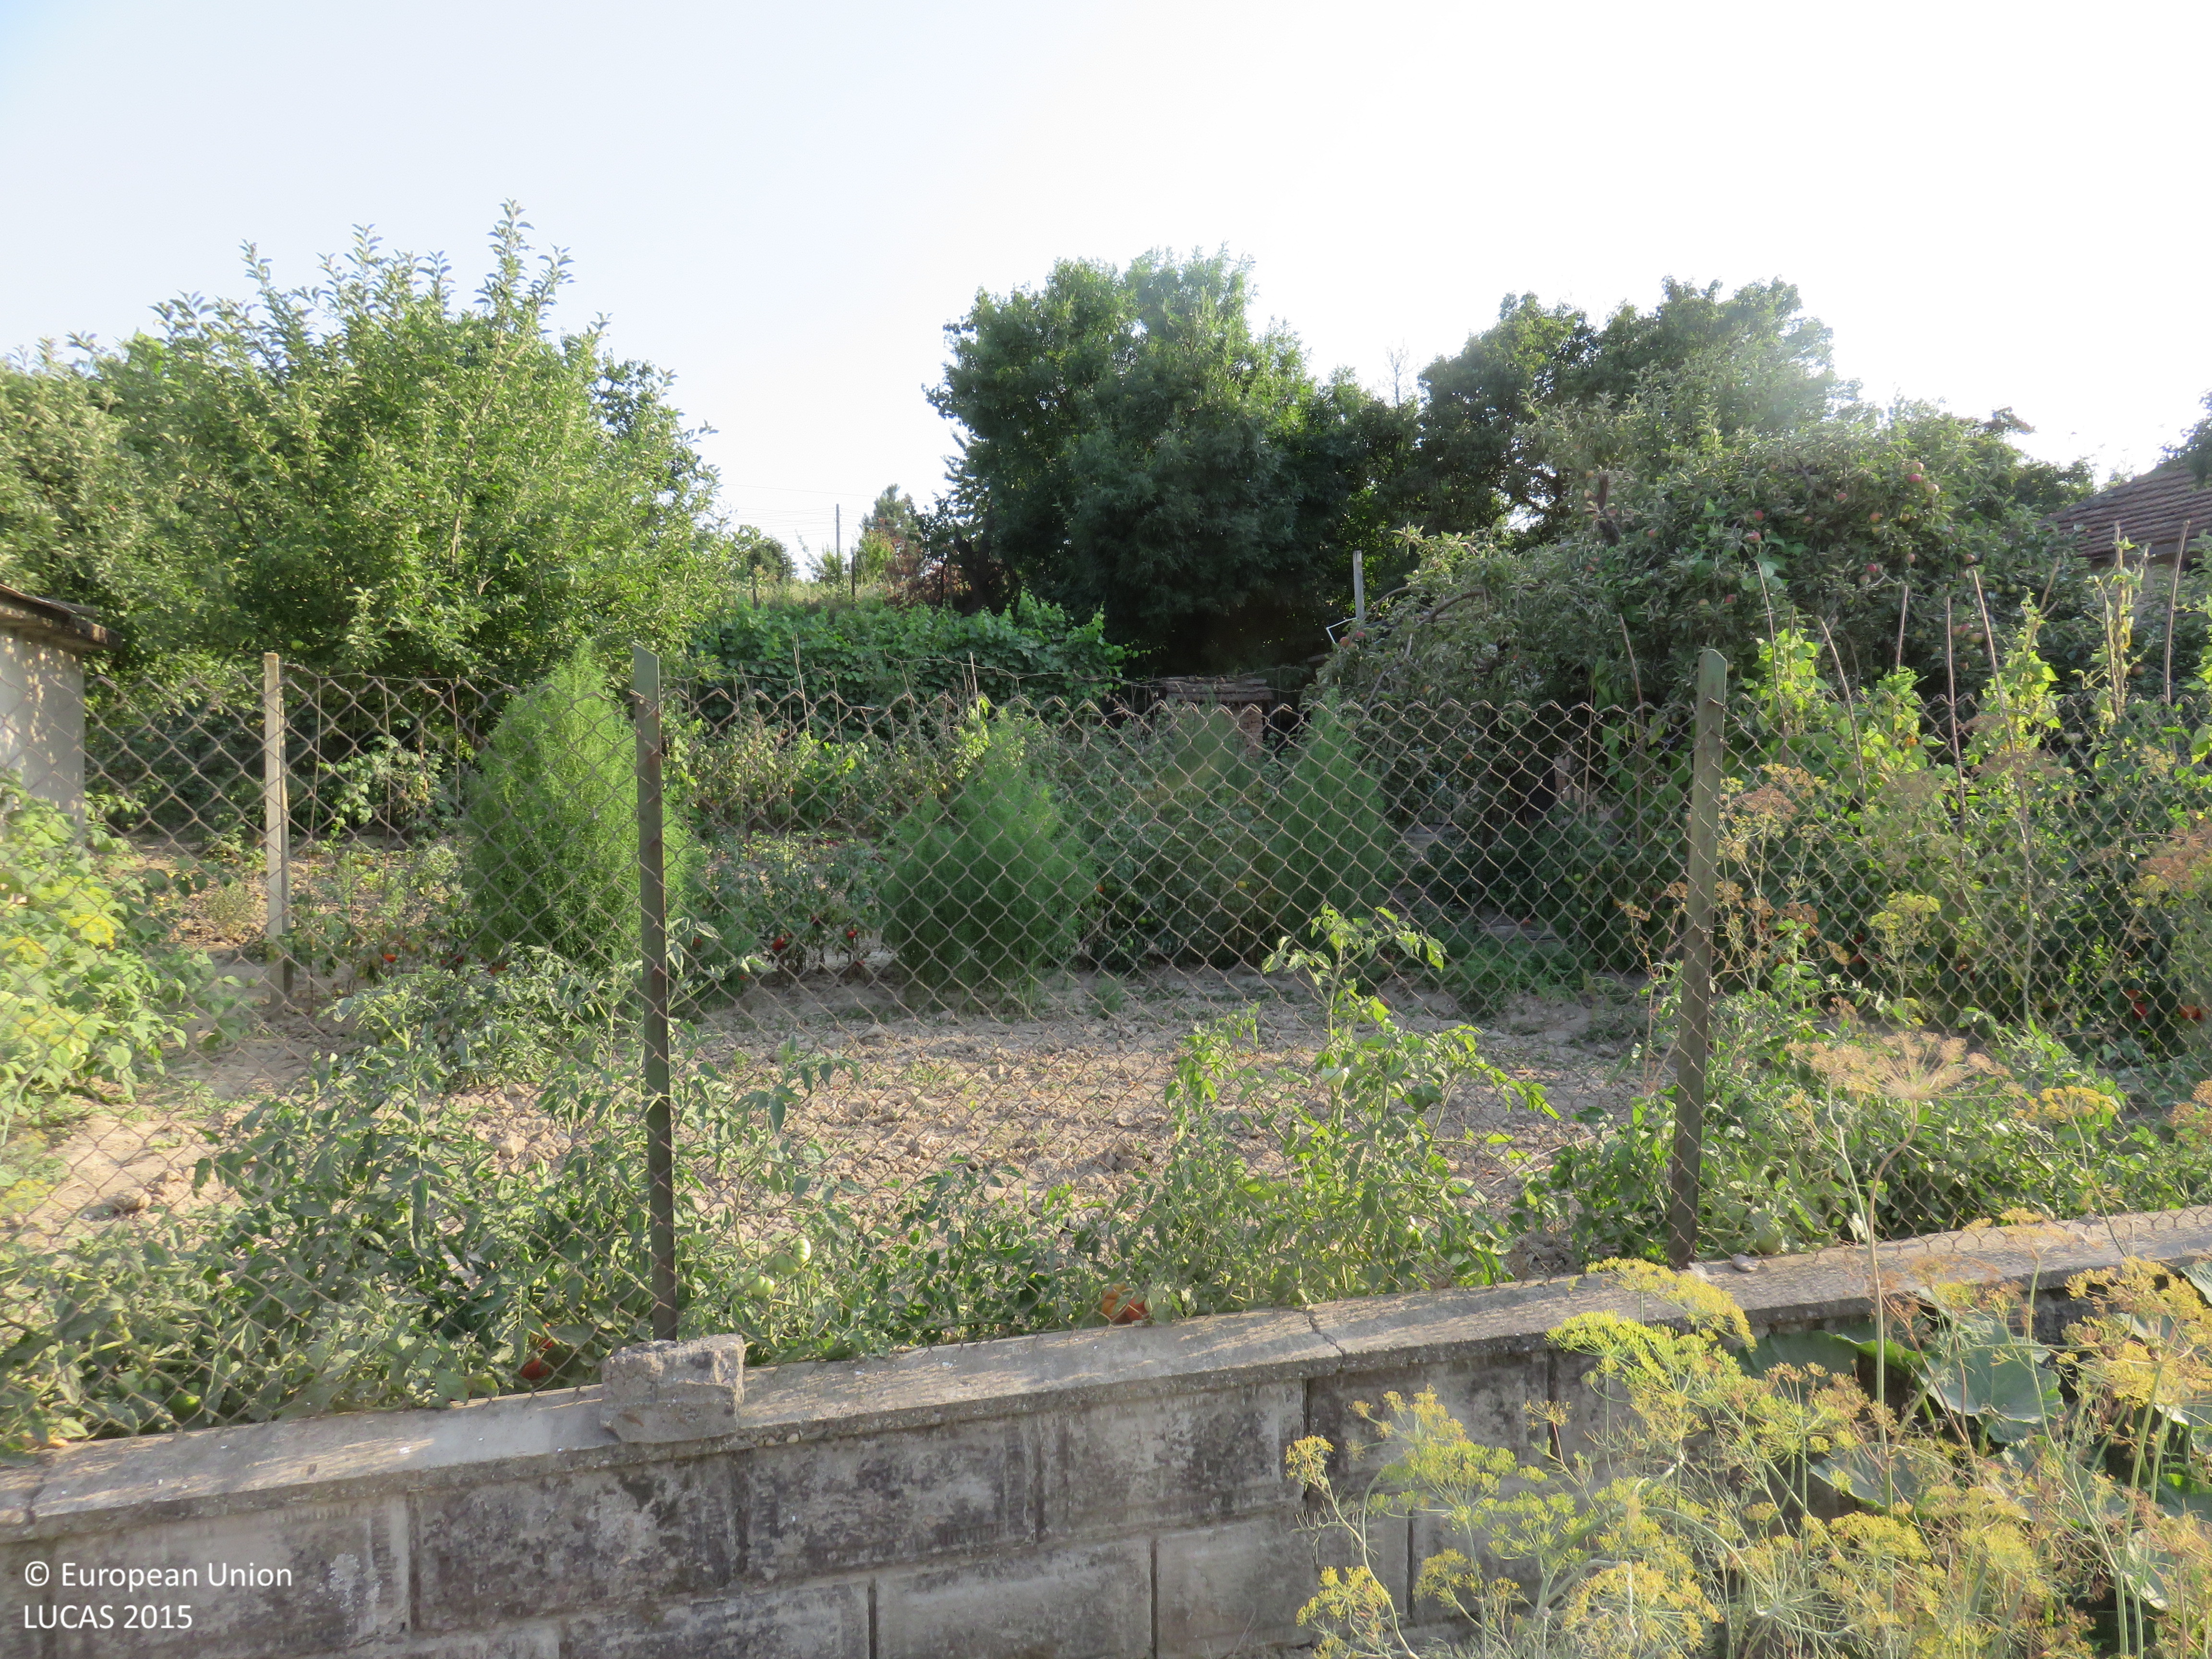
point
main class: Cropland
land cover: Vineyards
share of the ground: 50 - 75 %
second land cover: Other bare soil
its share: > 75 %
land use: Kitchen garden
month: July
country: BG
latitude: 43.6327
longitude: 25.0336
